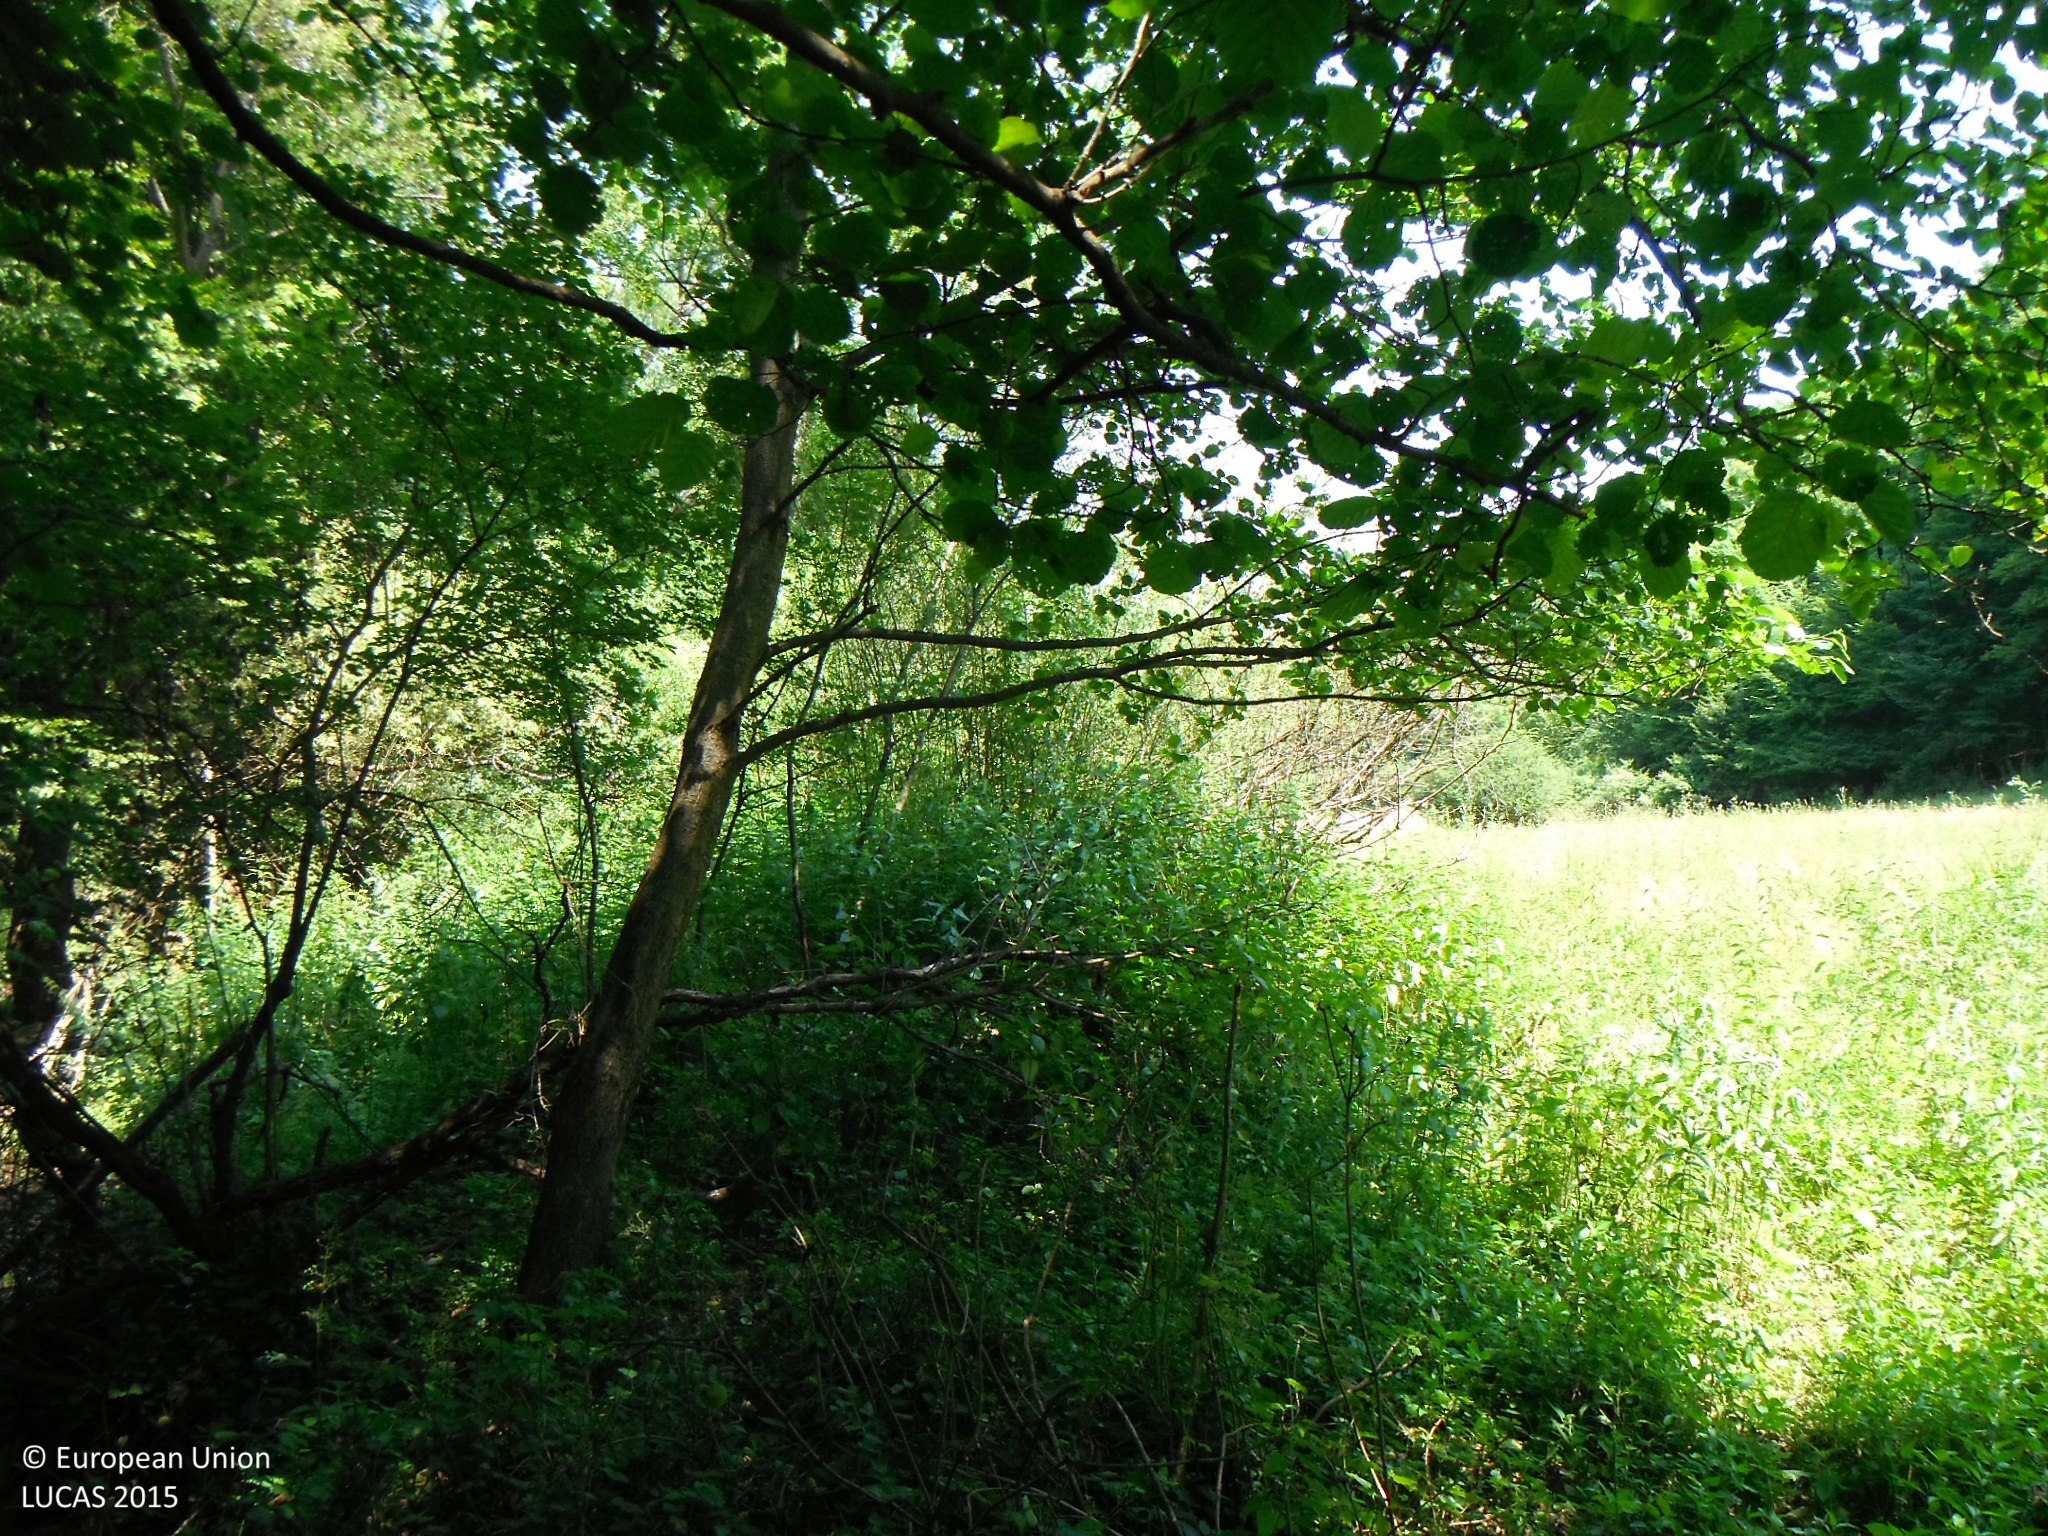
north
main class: Woodland
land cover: Broadleaved woodland
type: floodplain forest
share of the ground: > 75 %
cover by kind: broadleaved forest trees 100 %
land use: Forestry
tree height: > 5 m
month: July
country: SK
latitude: 48.2373
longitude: 19.1906
